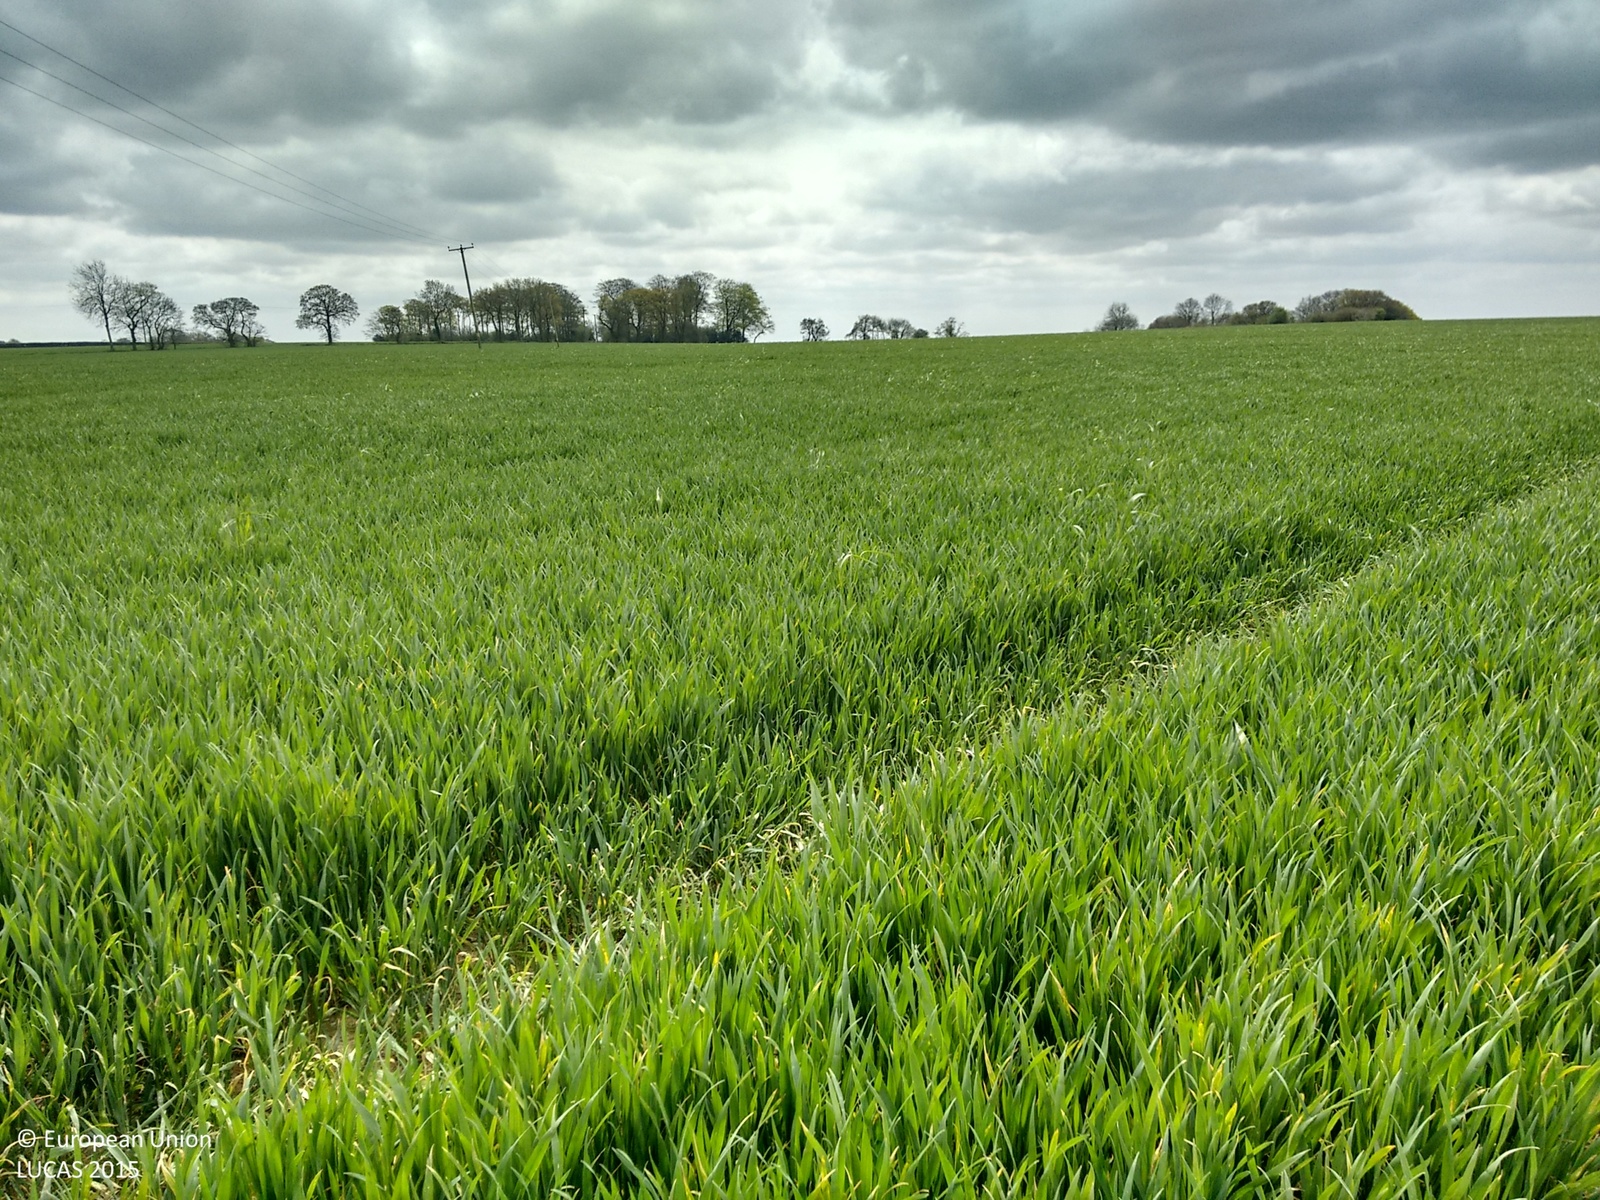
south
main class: Cropland
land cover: Common wheat
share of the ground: > 75 %
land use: Agriculture (excluding fallow land and kitchen gardens)
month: May
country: GB
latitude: 51.2386
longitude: 0.7646
